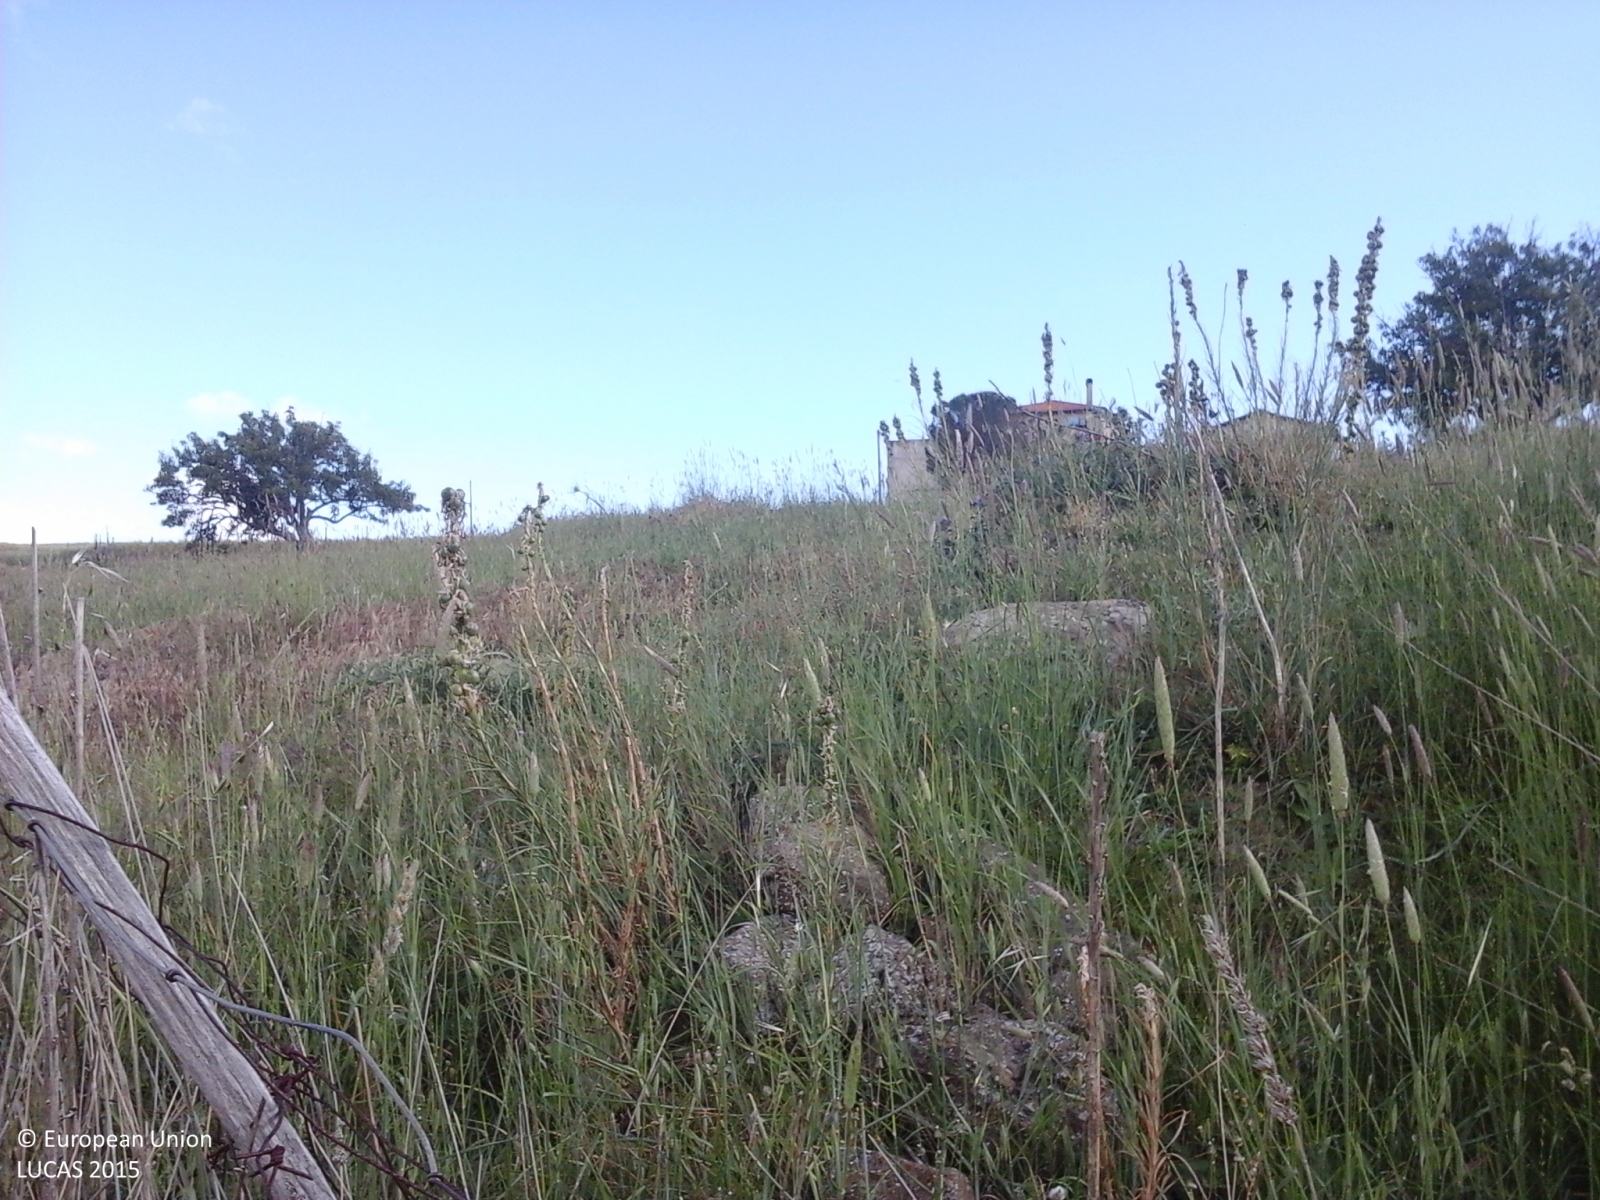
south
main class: Grassland
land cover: Grassland without tree/shrub cover
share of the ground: > 75 %
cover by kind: herbaceous plants 100 %
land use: Agriculture (excluding fallow land and kitchen gardens)
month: May
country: IT
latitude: 37.7896
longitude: 14.4314
